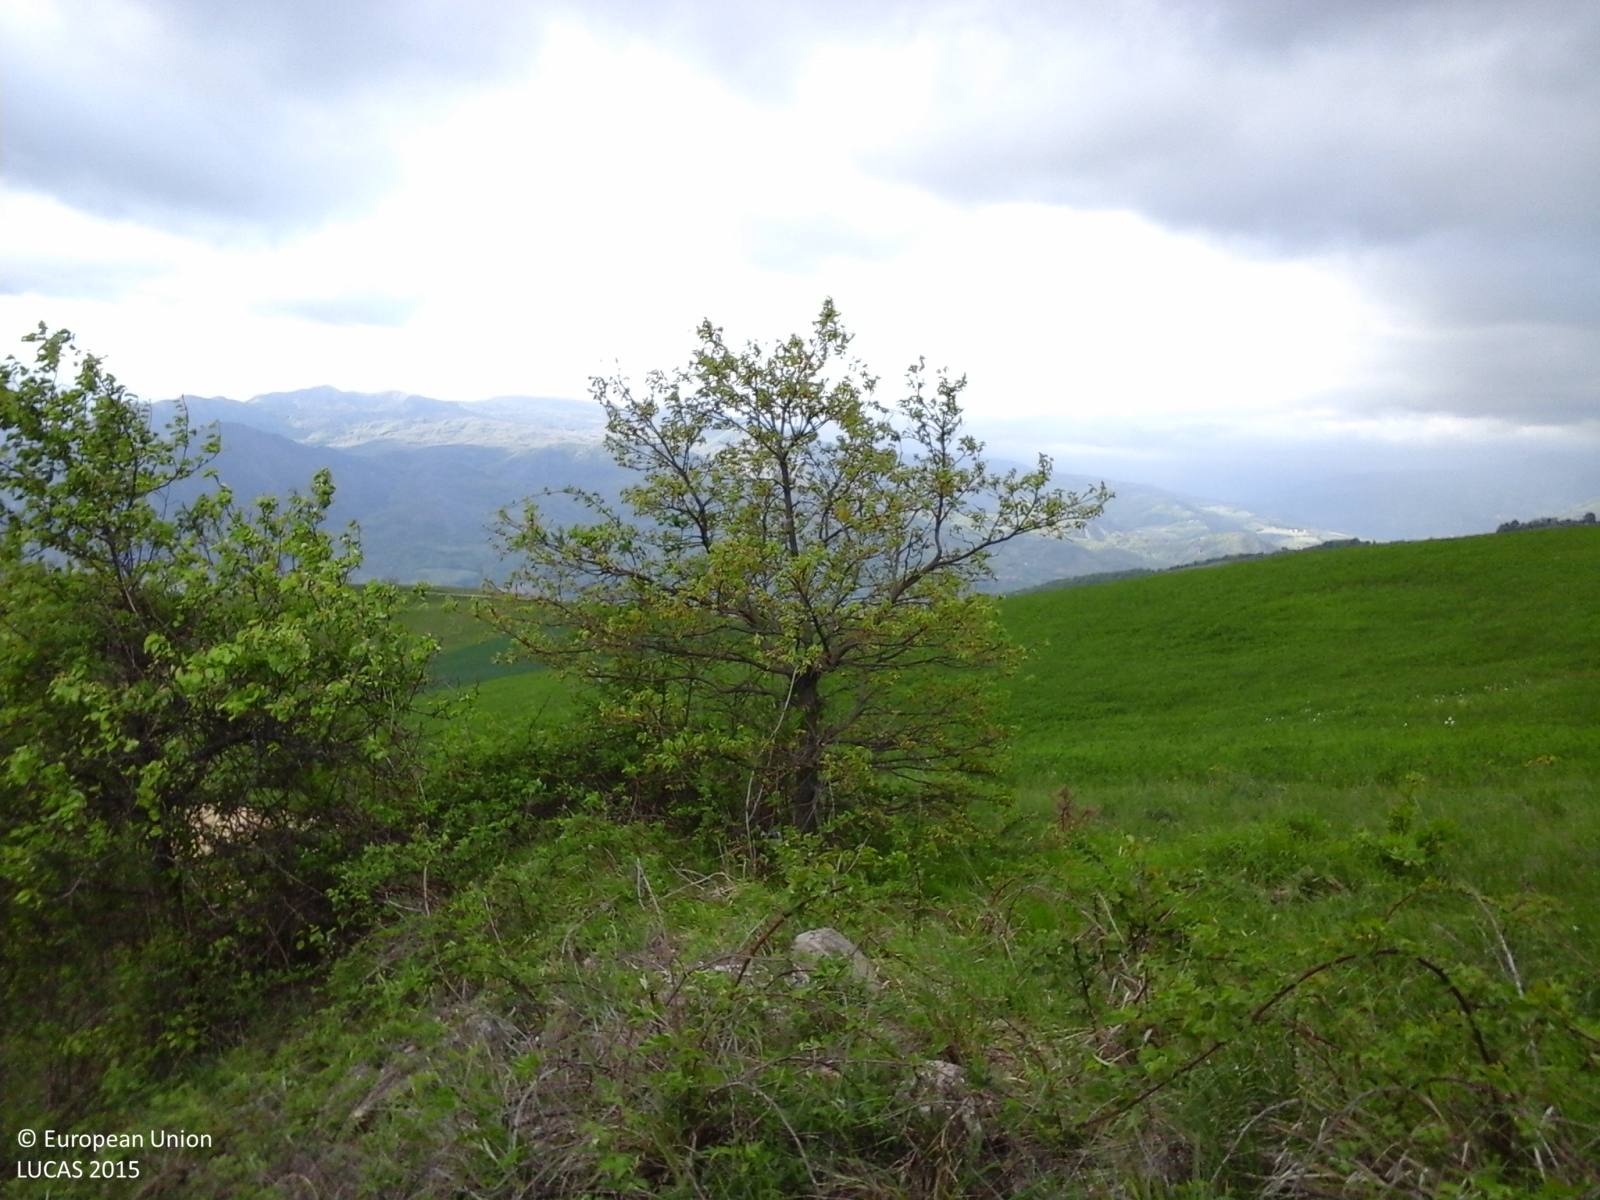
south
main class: Woodland
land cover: Broadleaved woodland
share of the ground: > 75 %
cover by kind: broadleaved forest trees 70 %, shrubs 20 %, herbaceous plants 10 %
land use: Forestry
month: May
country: IT
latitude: 44.8541
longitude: 9.4570
